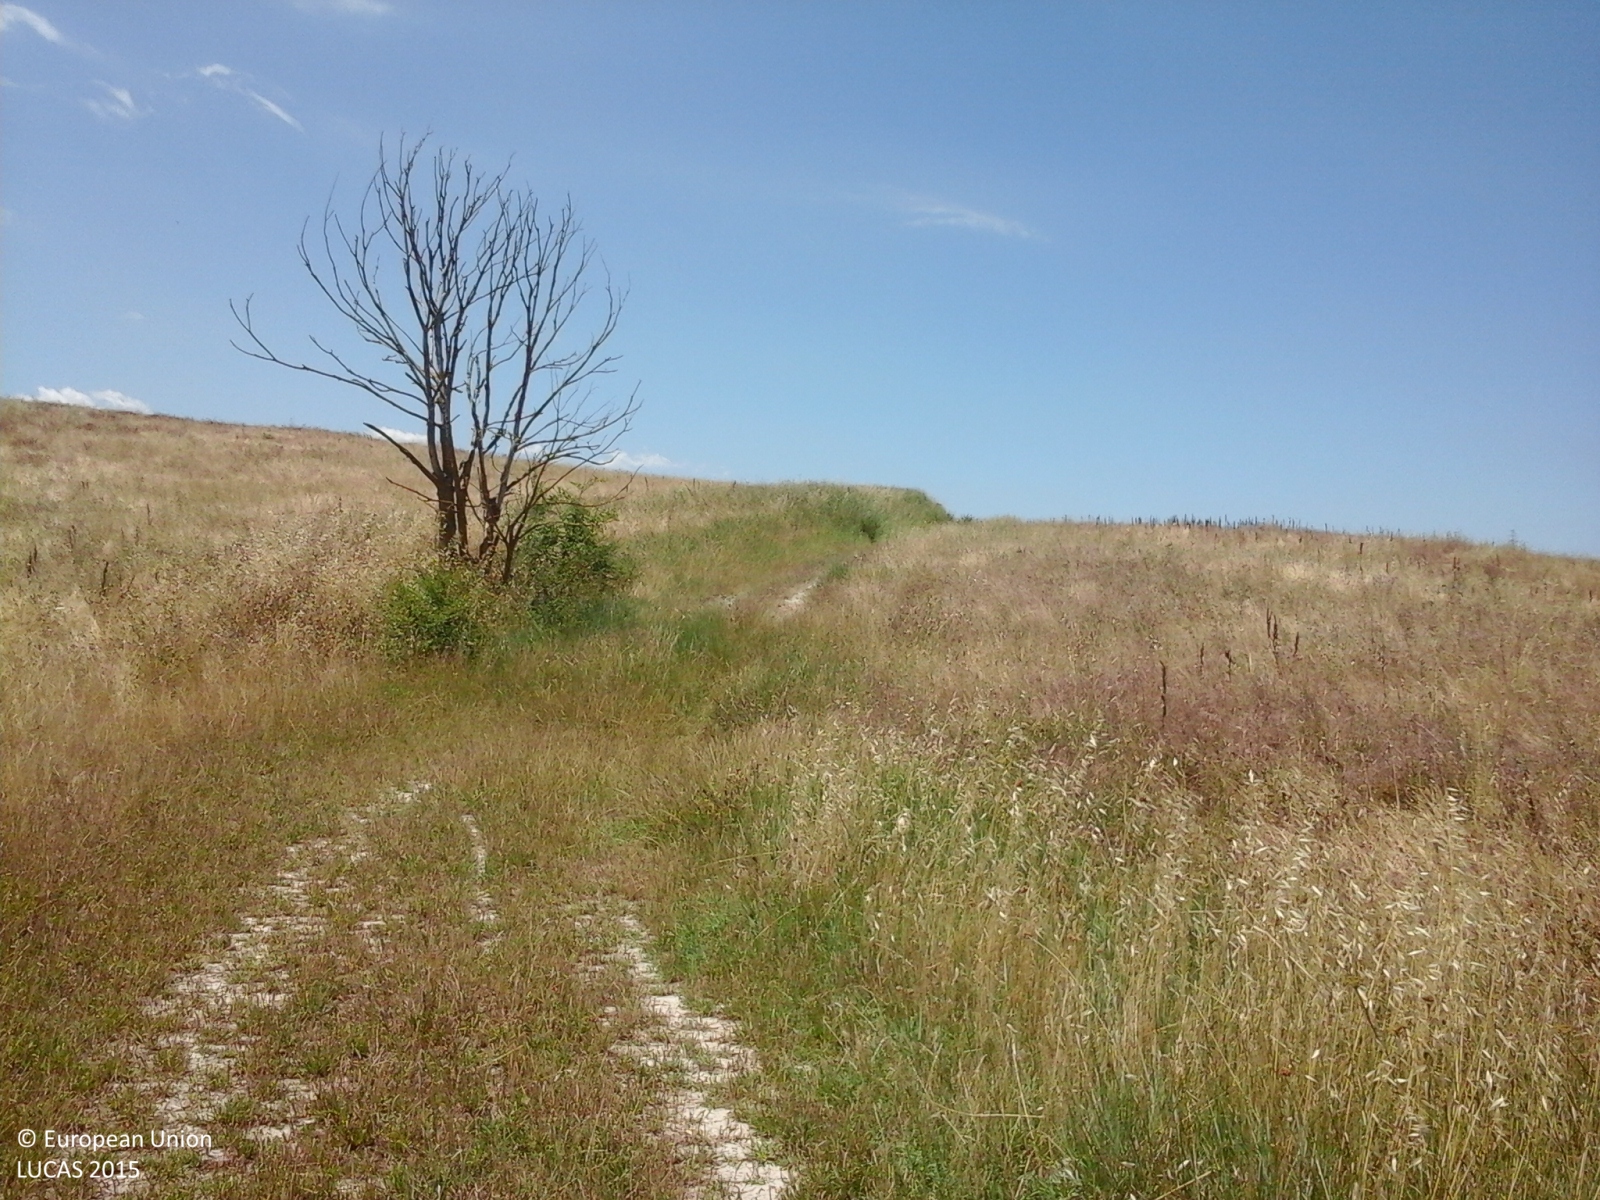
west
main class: Grassland
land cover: Grassland without tree/shrub cover
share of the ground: > 75 %
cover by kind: herbaceous plants 95 %, shrubs 5 %
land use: Agriculture (excluding fallow land and kitchen gardens)
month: June
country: IT
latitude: 43.5884
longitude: 10.9511
